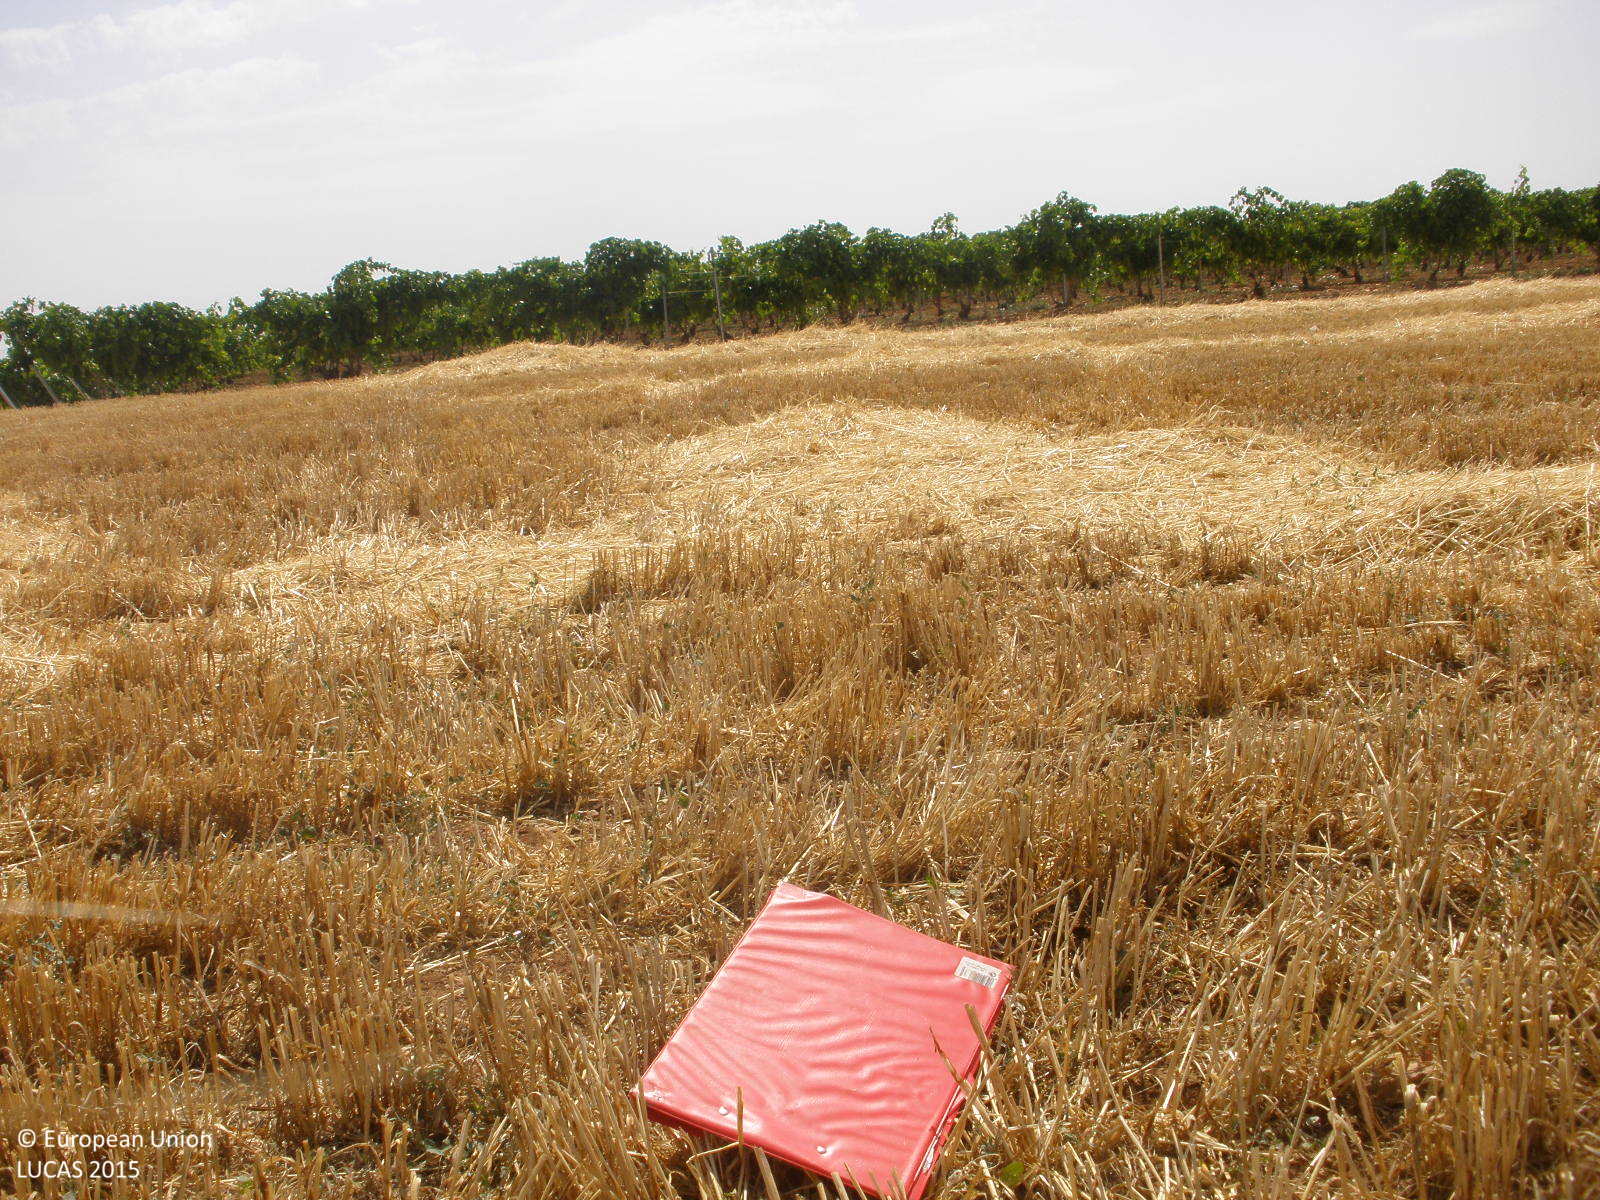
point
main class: Cropland
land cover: Barley
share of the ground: < 10 %
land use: Agriculture (excluding fallow land and kitchen gardens)
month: July
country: ES
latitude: 39.9083
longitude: -3.4211
